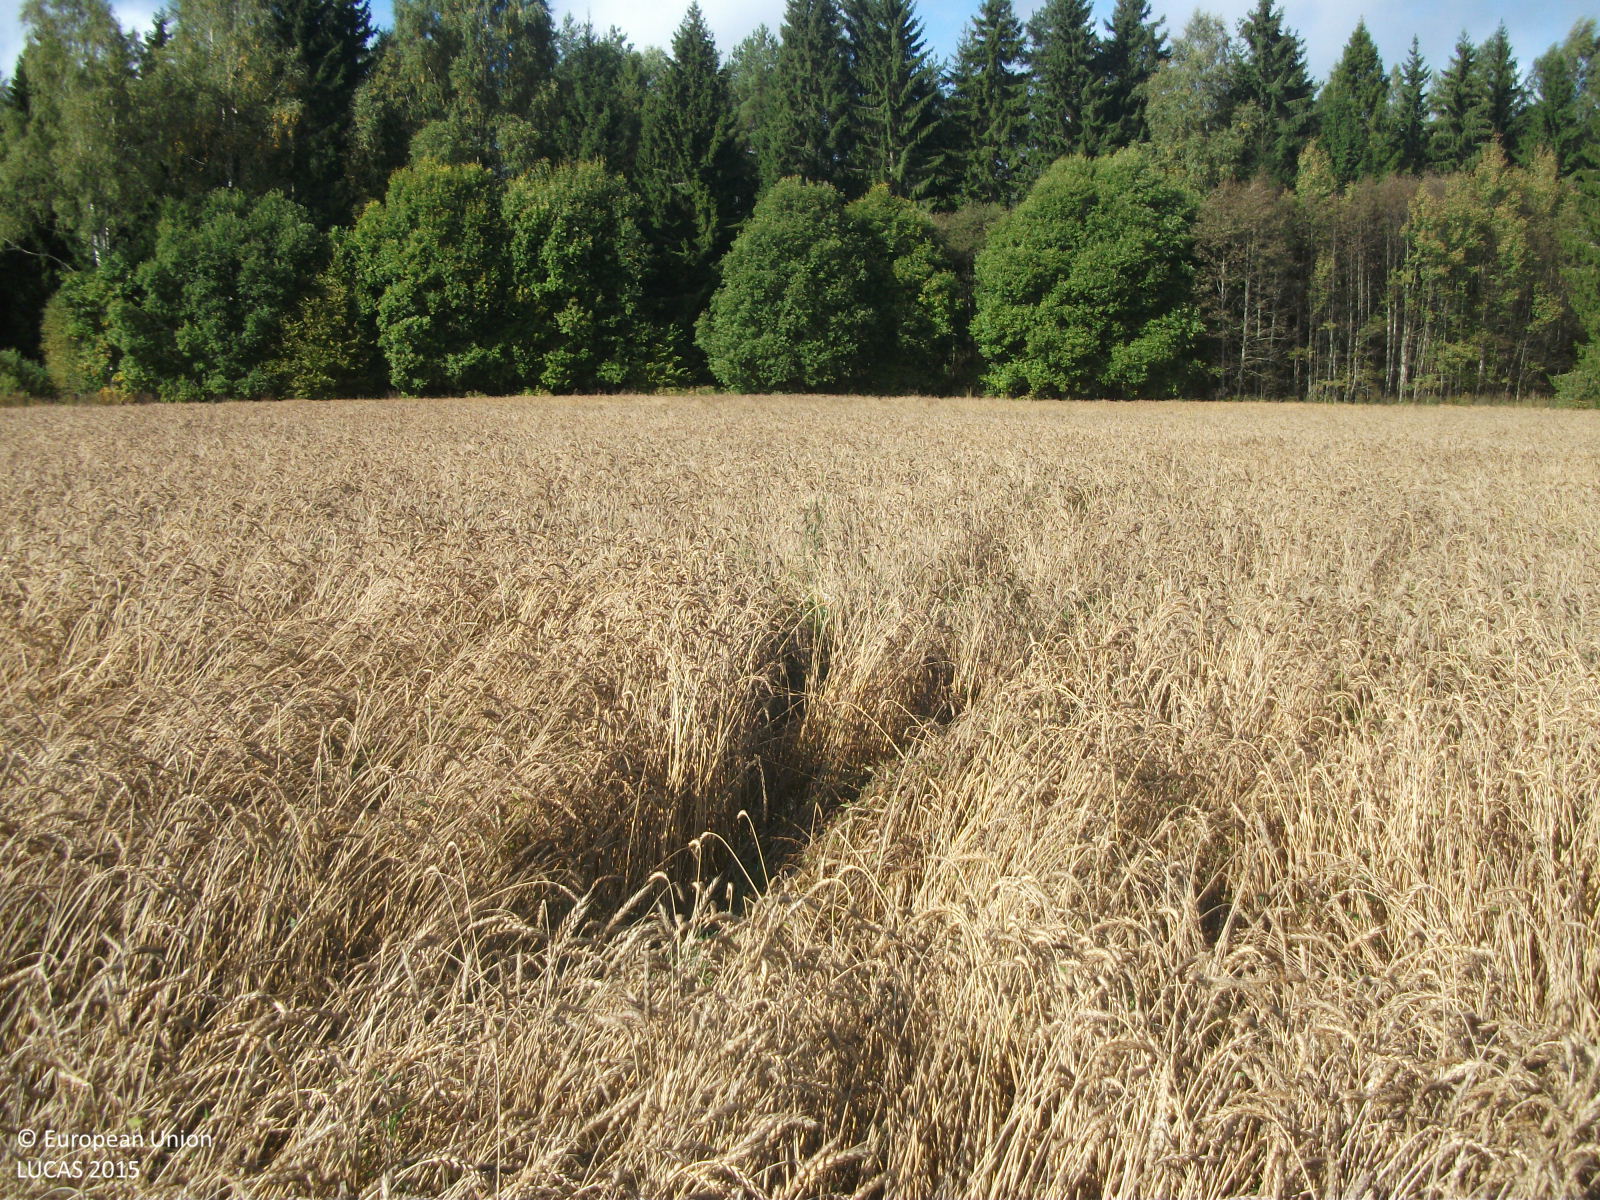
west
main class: Cropland
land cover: Common wheat
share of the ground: > 75 %
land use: Agriculture (excluding fallow land and kitchen gardens)
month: September
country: LV
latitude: 57.7312
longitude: 24.8939
